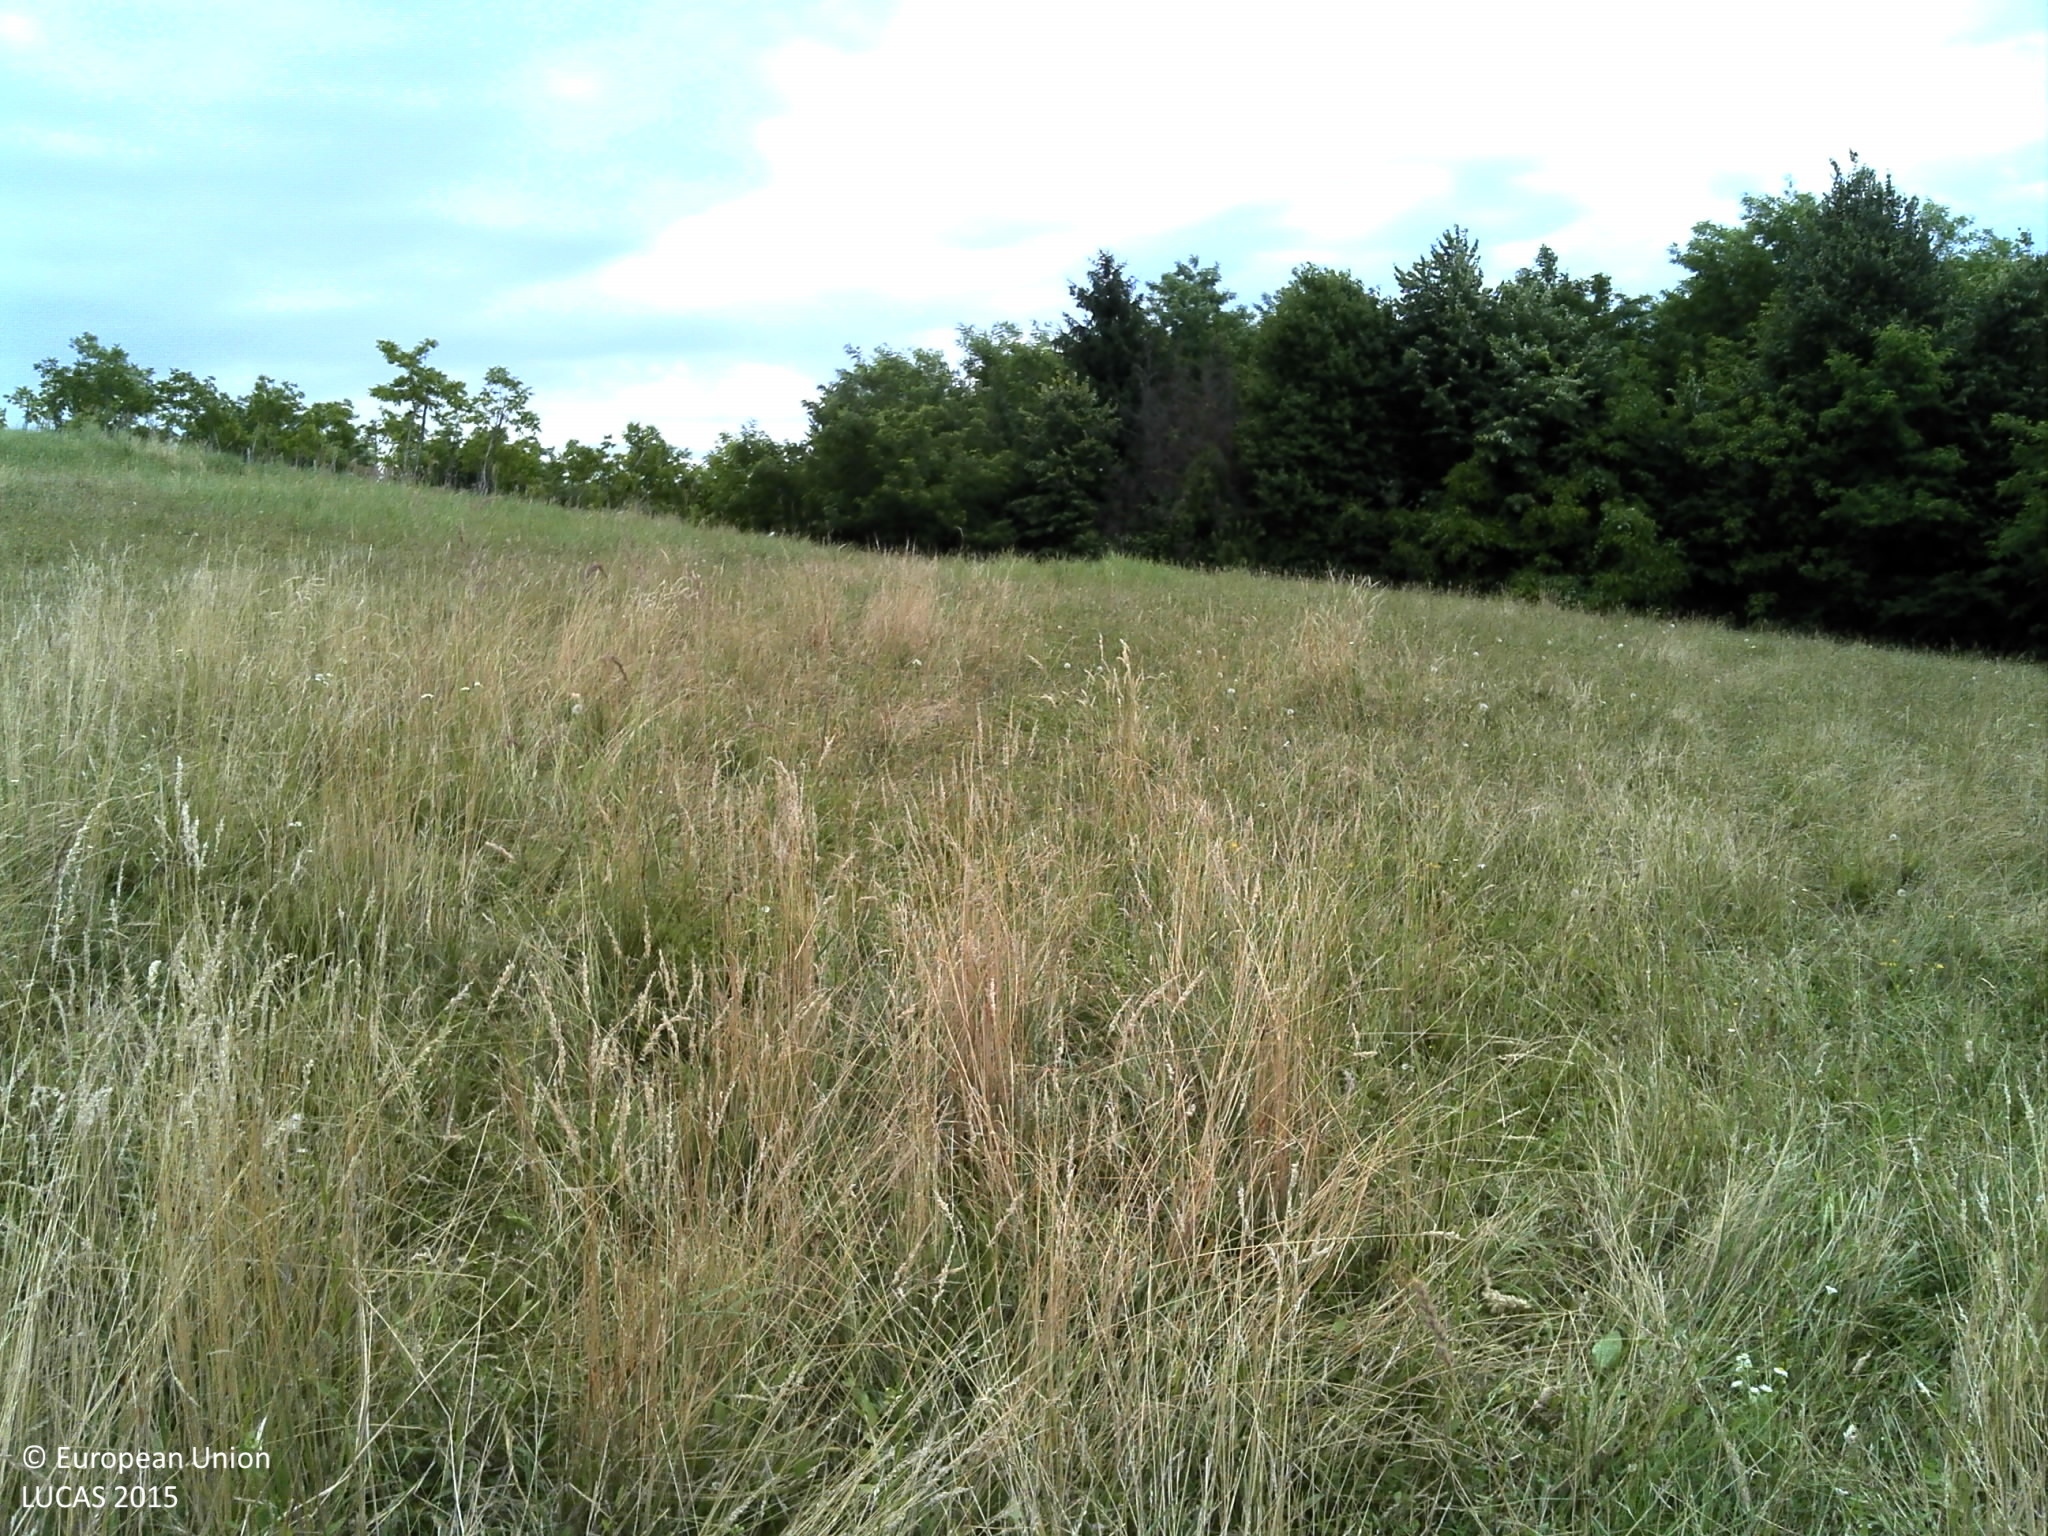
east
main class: Grassland
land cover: Grassland without tree/shrub cover
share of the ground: > 75 %
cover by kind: herbaceous plants 100 %
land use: Agriculture (excluding fallow land and kitchen gardens)
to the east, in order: Grassland without tree/shrub cover; Nuts trees; Shrubland with sparse tree cover
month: June
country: HR
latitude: 45.7640
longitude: 17.4728
